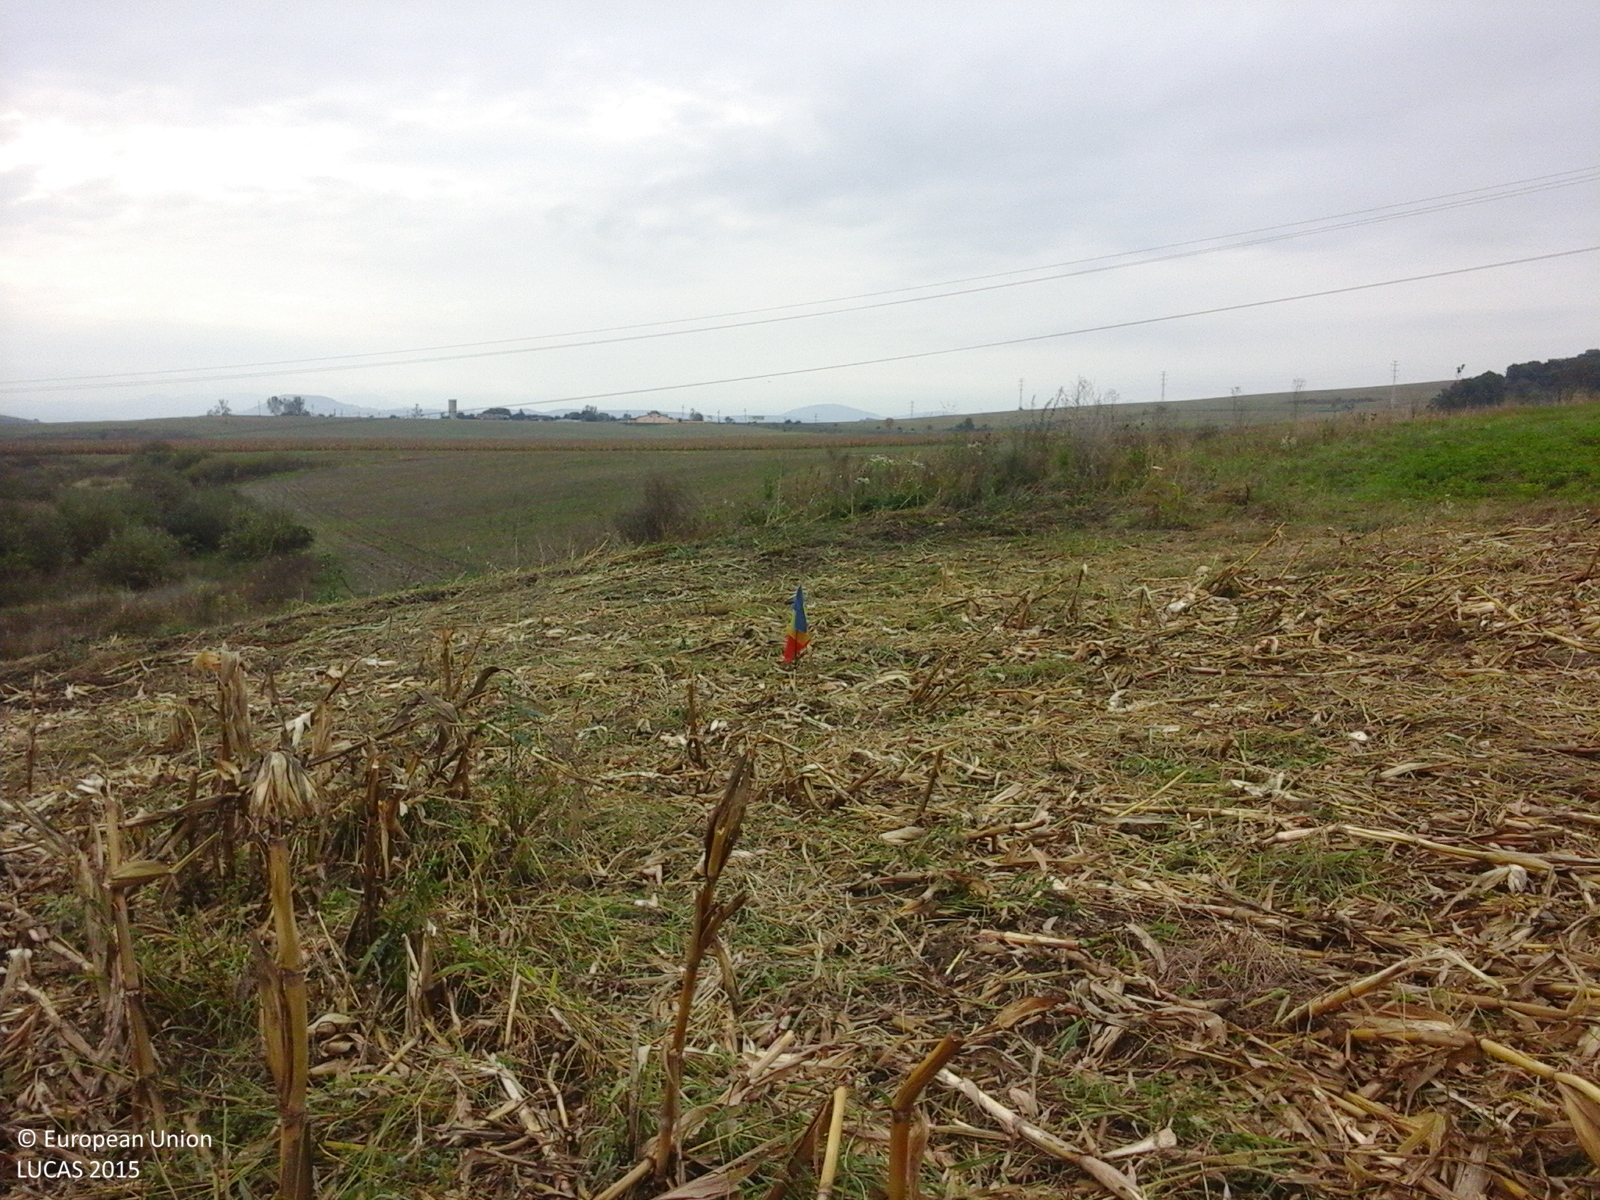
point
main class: Cropland
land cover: Maize
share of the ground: 25 - 50 %
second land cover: Spontaneously vegetated surfaces
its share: 25 - 50 %
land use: Agriculture (excluding fallow land and kitchen gardens)
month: October
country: RO
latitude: 46.0364
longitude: 25.2559
